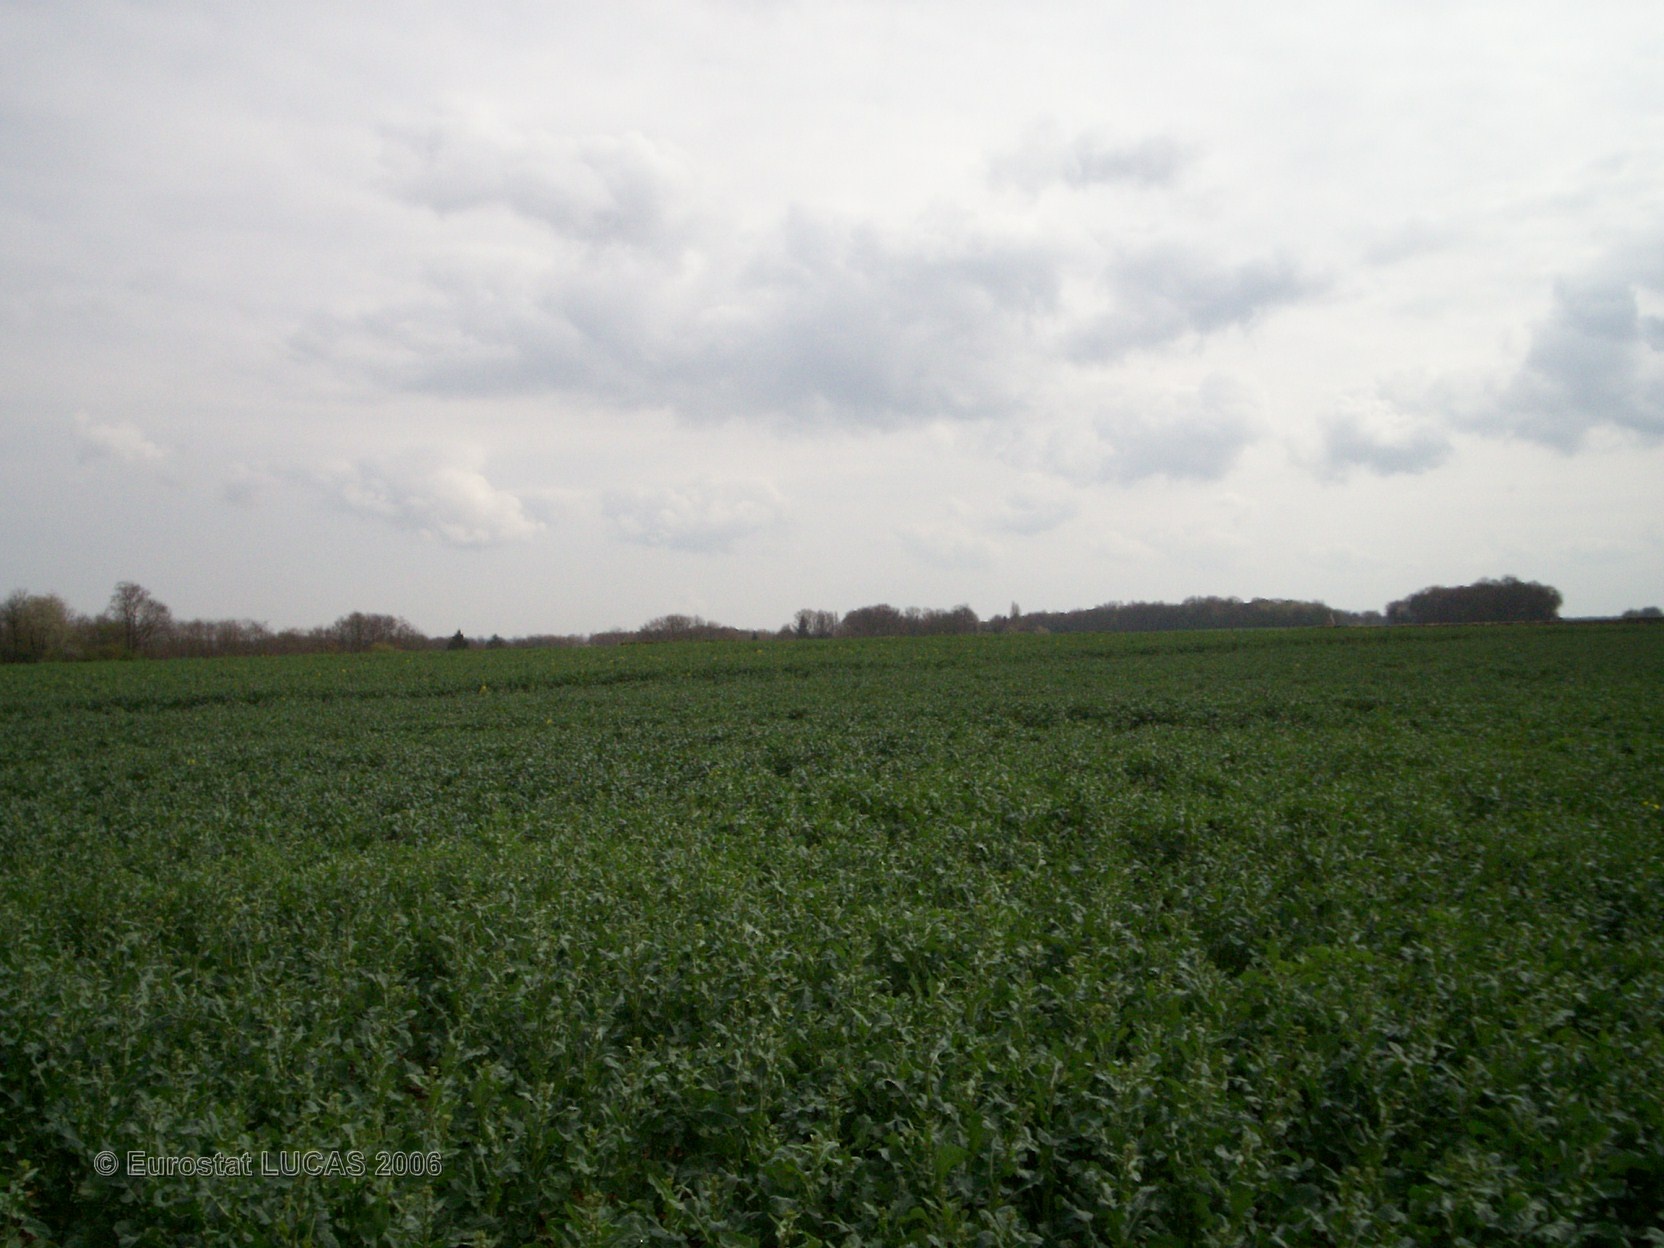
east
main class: Cropland
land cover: Rape and turnip rape
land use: Agriculture (excluding fallow land and kitchen gardens)
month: April
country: FR
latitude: 48.2632
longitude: 2.8655
